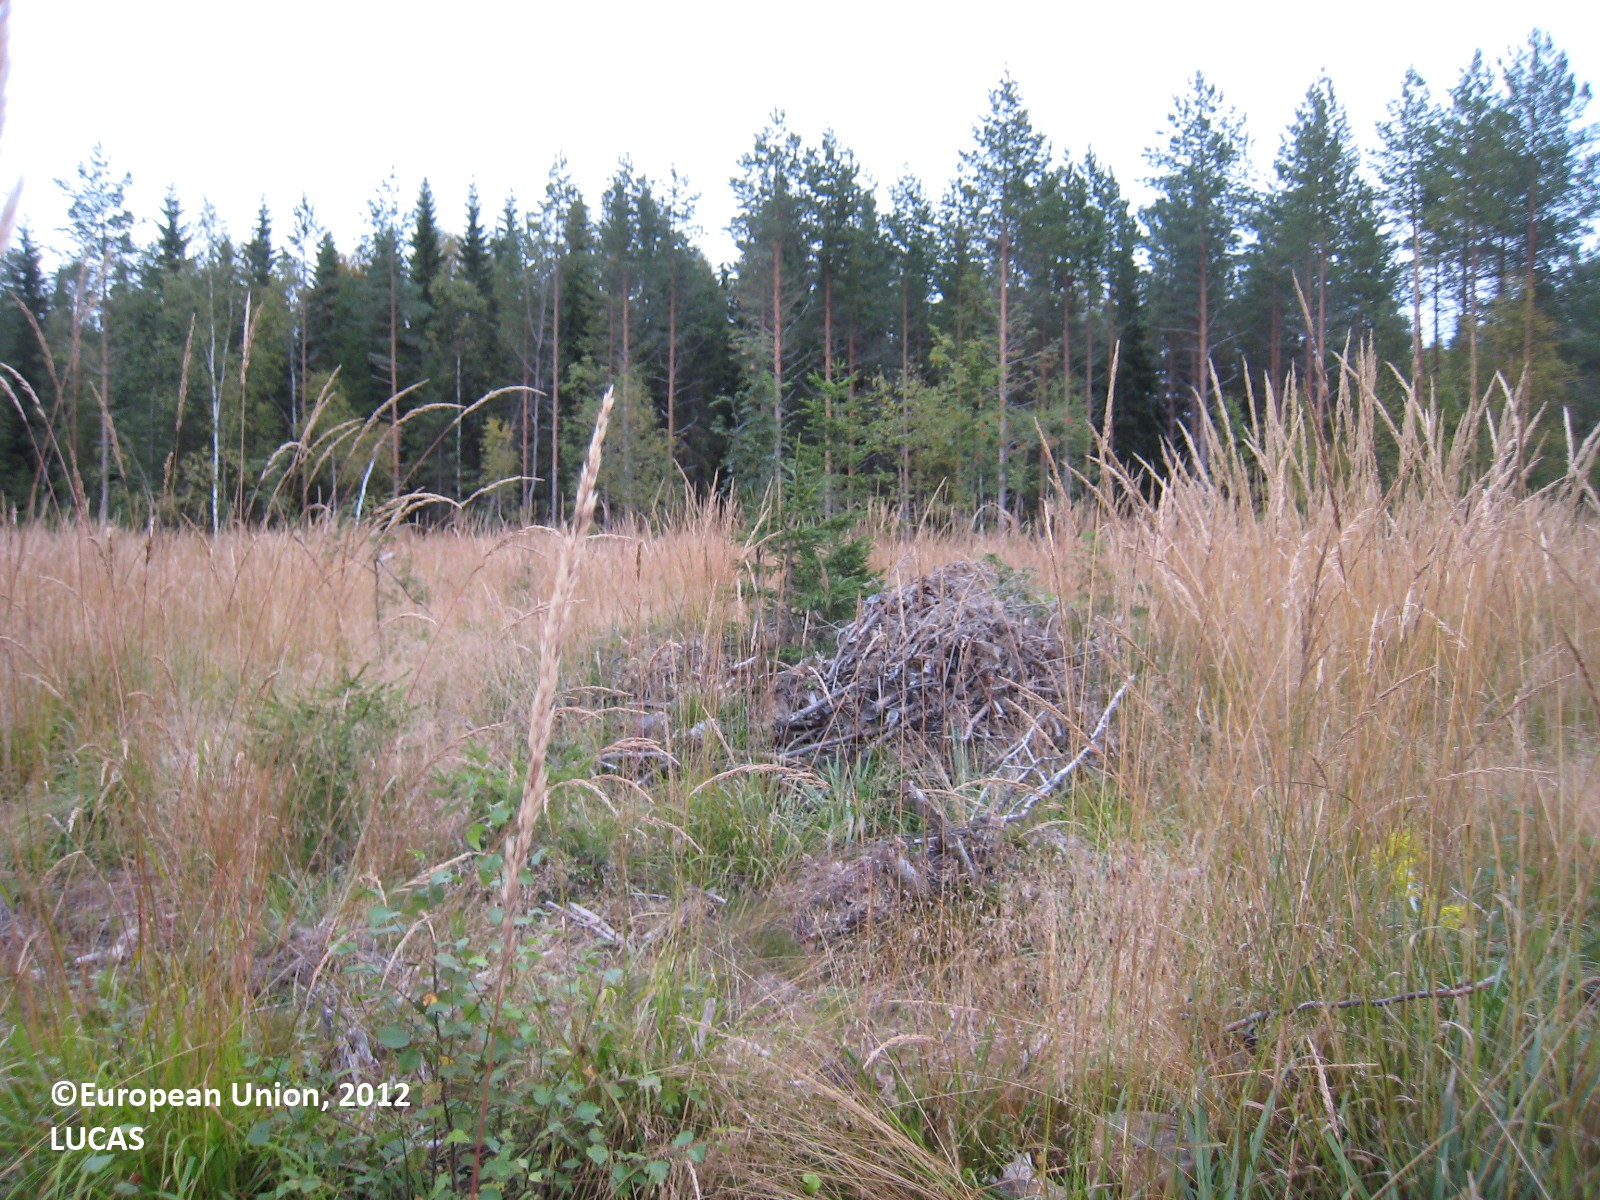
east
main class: Grassland
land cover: Grassland with sparse tree/shrub cover
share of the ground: > 75 %
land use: Forestry
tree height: < 5 m
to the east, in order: Grassland with sparse tree/shrub cover; Other coniferous woodland; Spruce dominated mixed woodland; Ditches and canals; Spruce dominated mixed woodland; Ditches and canals; Spruce dominated mixed woodland; Broadleaved woodland; Pine dominated mixed woodland
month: August
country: FI
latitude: 62.3371
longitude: 27.3279
